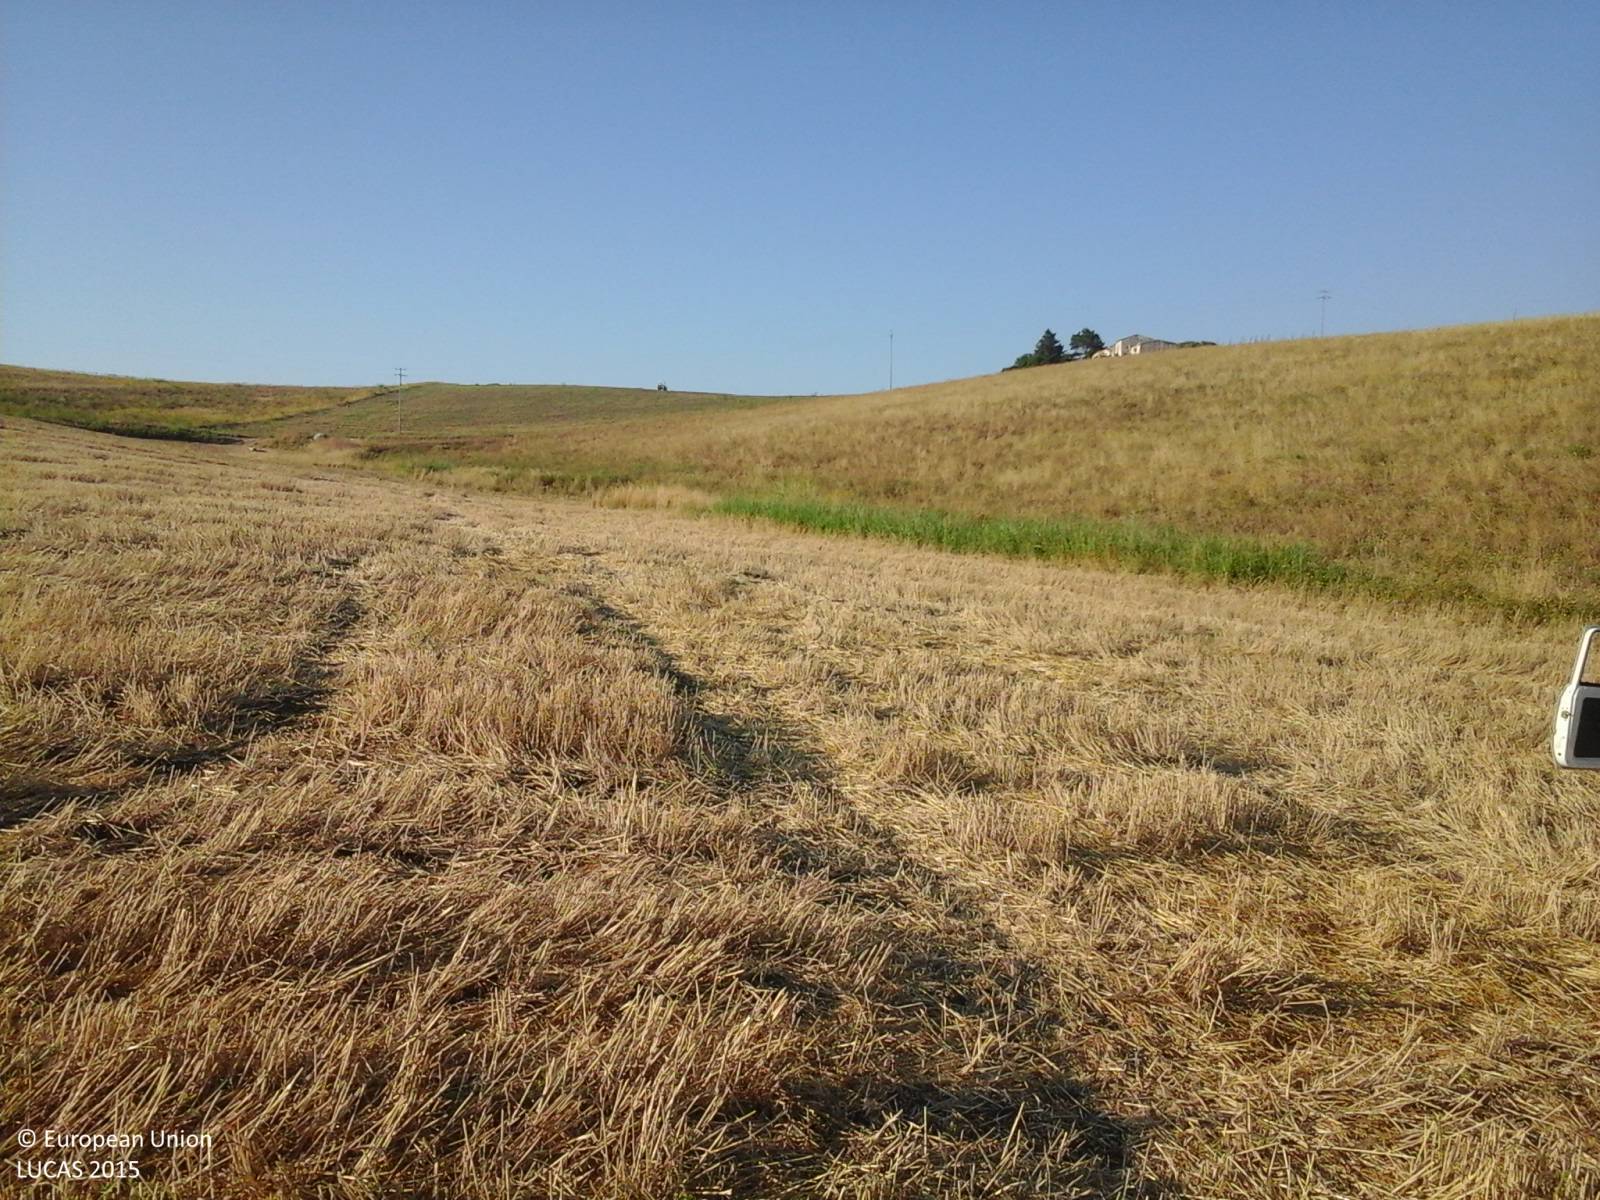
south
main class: Cropland
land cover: Durum wheat
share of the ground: > 75 %
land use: Agriculture (excluding fallow land and kitchen gardens)
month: July
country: IT
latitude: 37.8800
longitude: 13.0588
